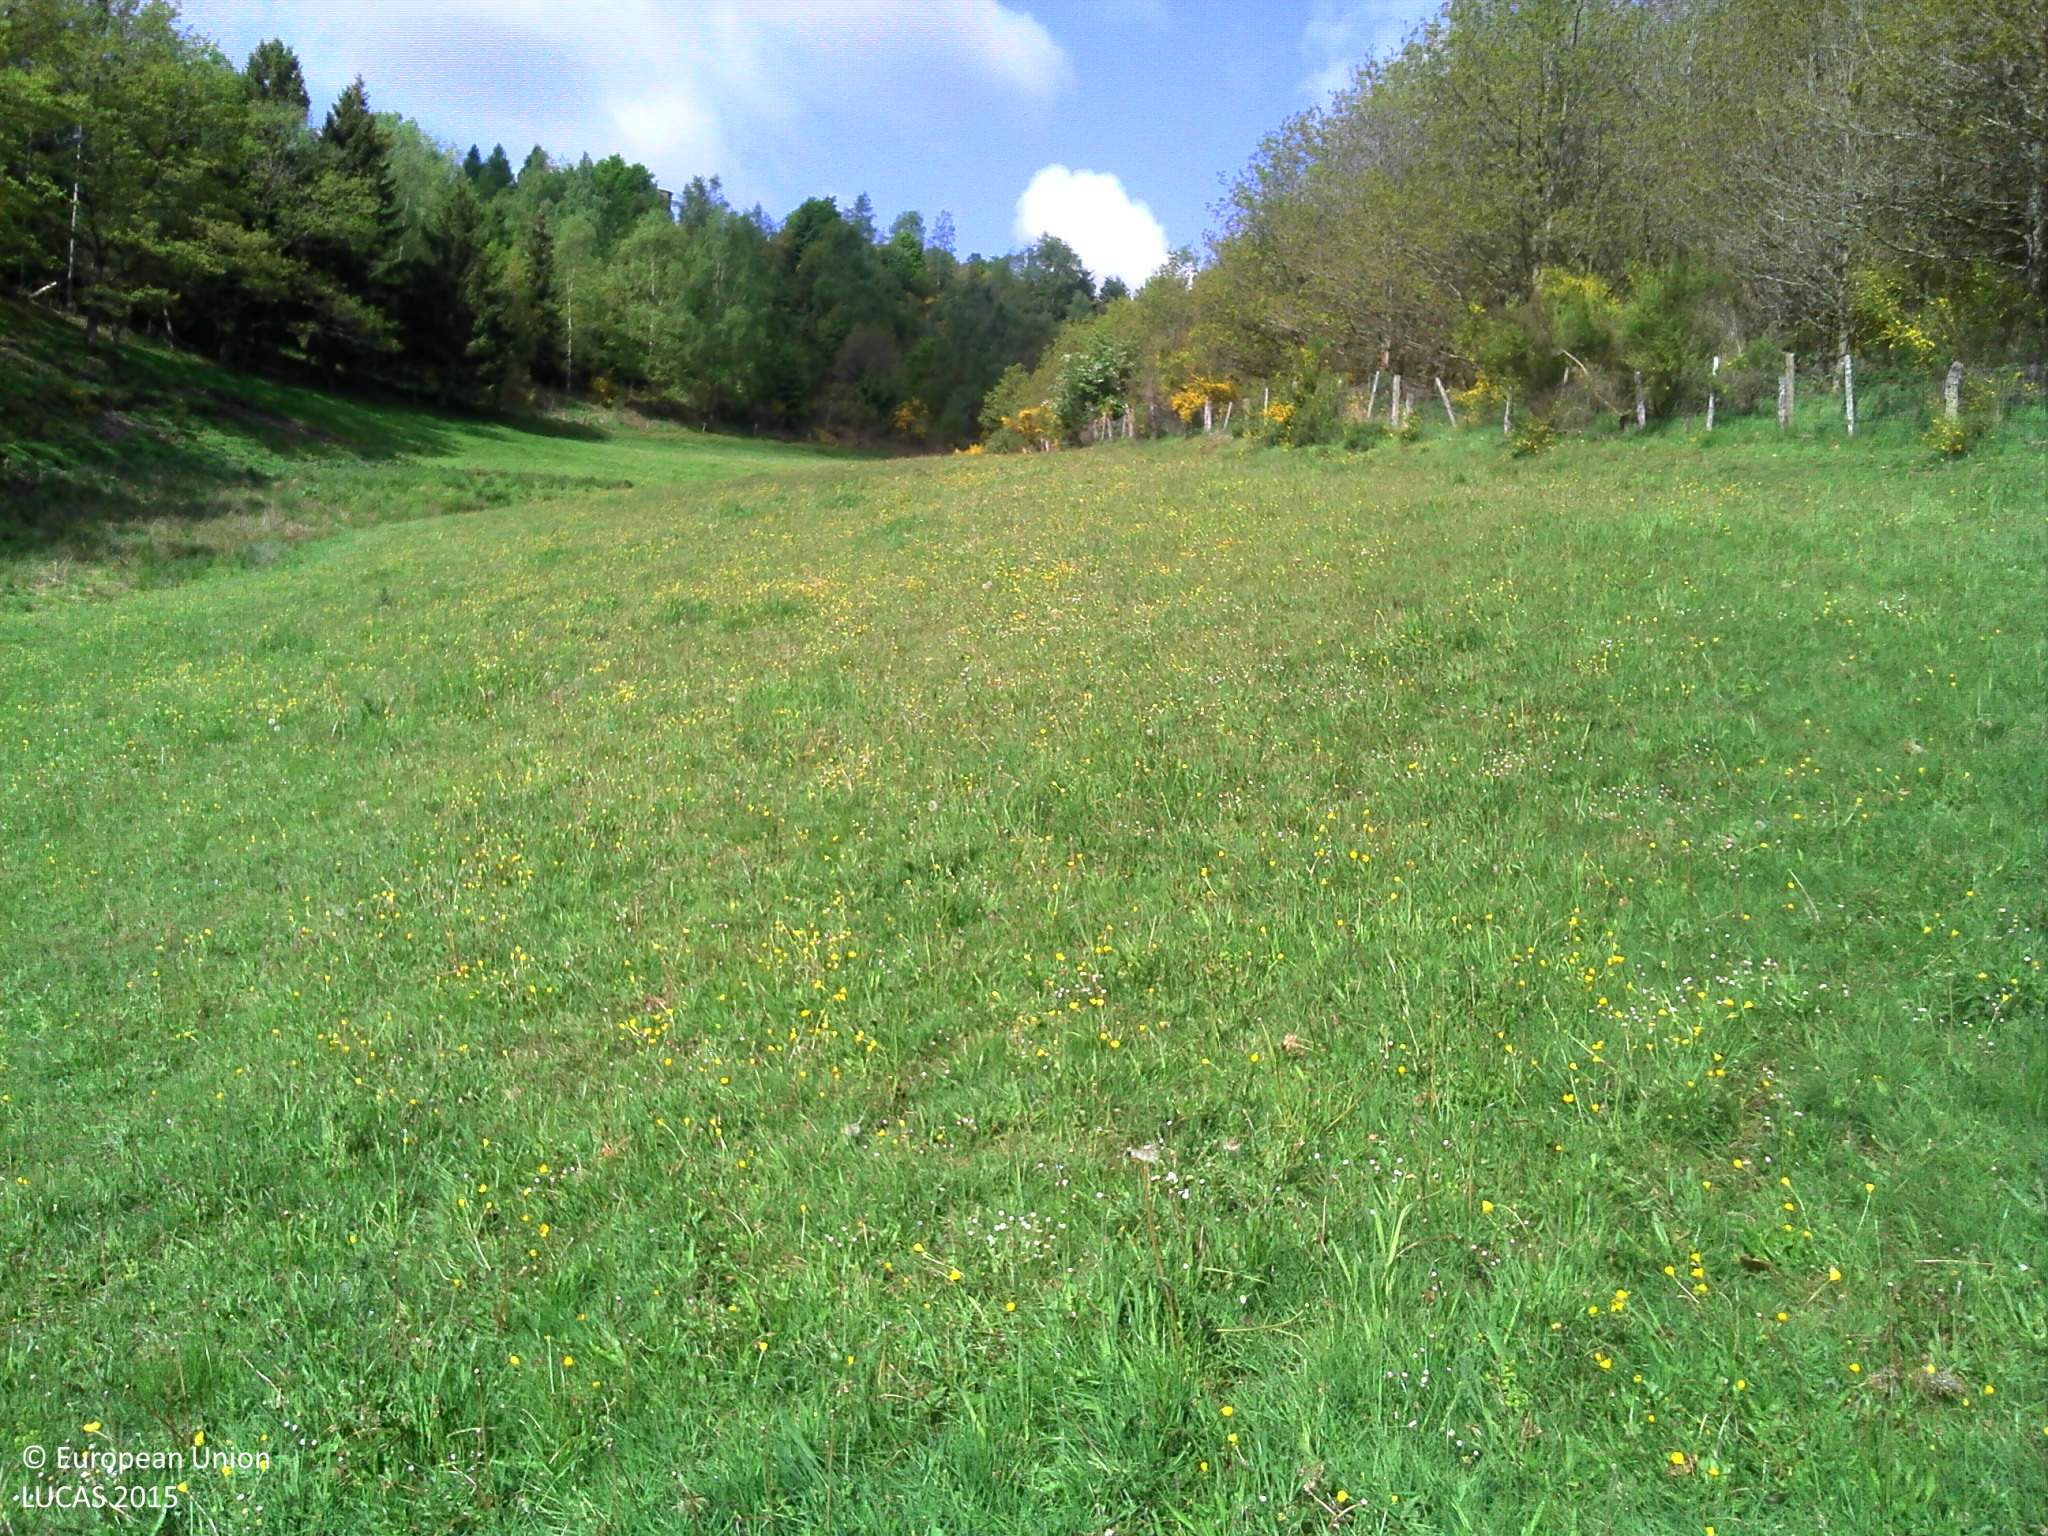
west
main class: Grassland
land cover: Grassland without tree/shrub cover
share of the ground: > 75 %
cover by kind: herbaceous plants 100 %
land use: Agriculture (excluding fallow land and kitchen gardens)
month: May
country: LU
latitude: 50.0398
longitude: 5.9359
